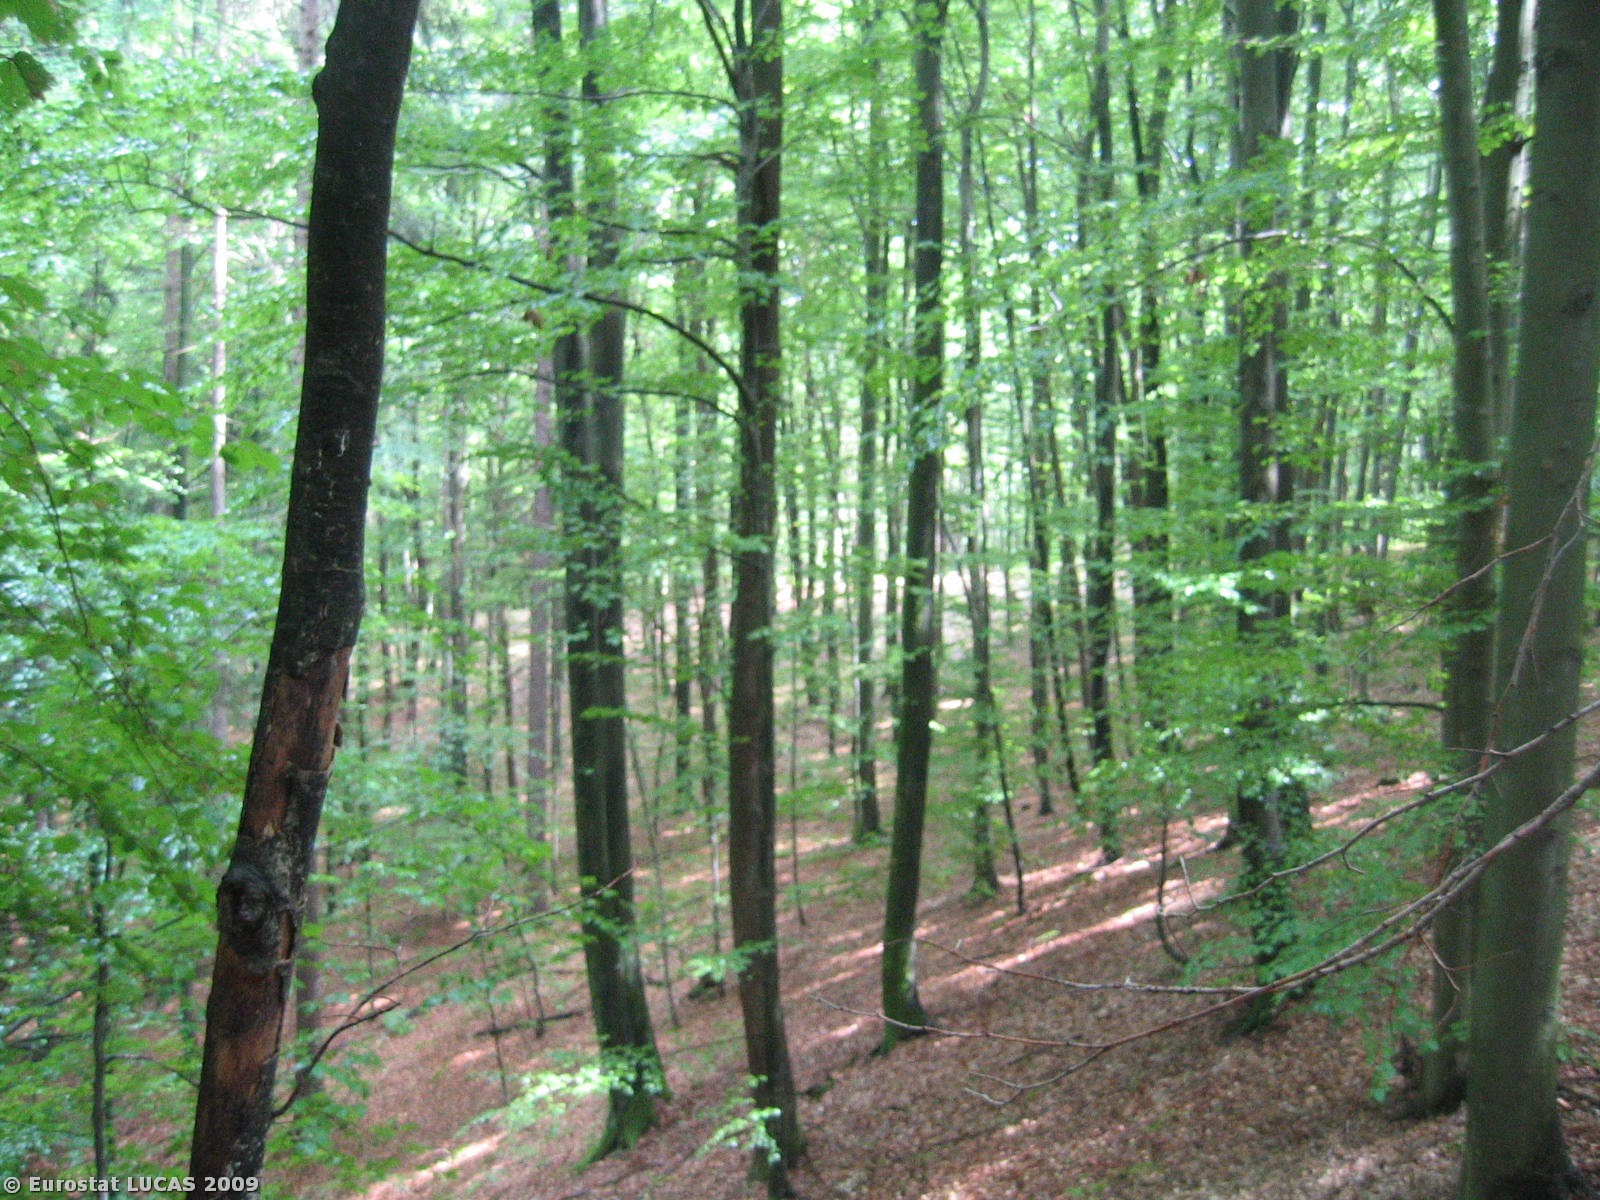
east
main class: Woodland
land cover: Mixed woodland
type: hemiboreal forest and nemoral coniferous forest and mixed broadleaved-coniferous forest
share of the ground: > 75 %
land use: Forestry
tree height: > 5 m
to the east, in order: Mixed woodland; Ditches and canals; Mixed woodland; Tracks; Mixed woodland; Ditches and canals; Rivers and streams; Ditches and canals; Grassland with sparse tree/shrub cover; Tracks; Managed hedges; Artificial constructions in urban areas; Grassland without tree/shrub cover
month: July
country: SI
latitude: 46.0103
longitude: 14.3486
